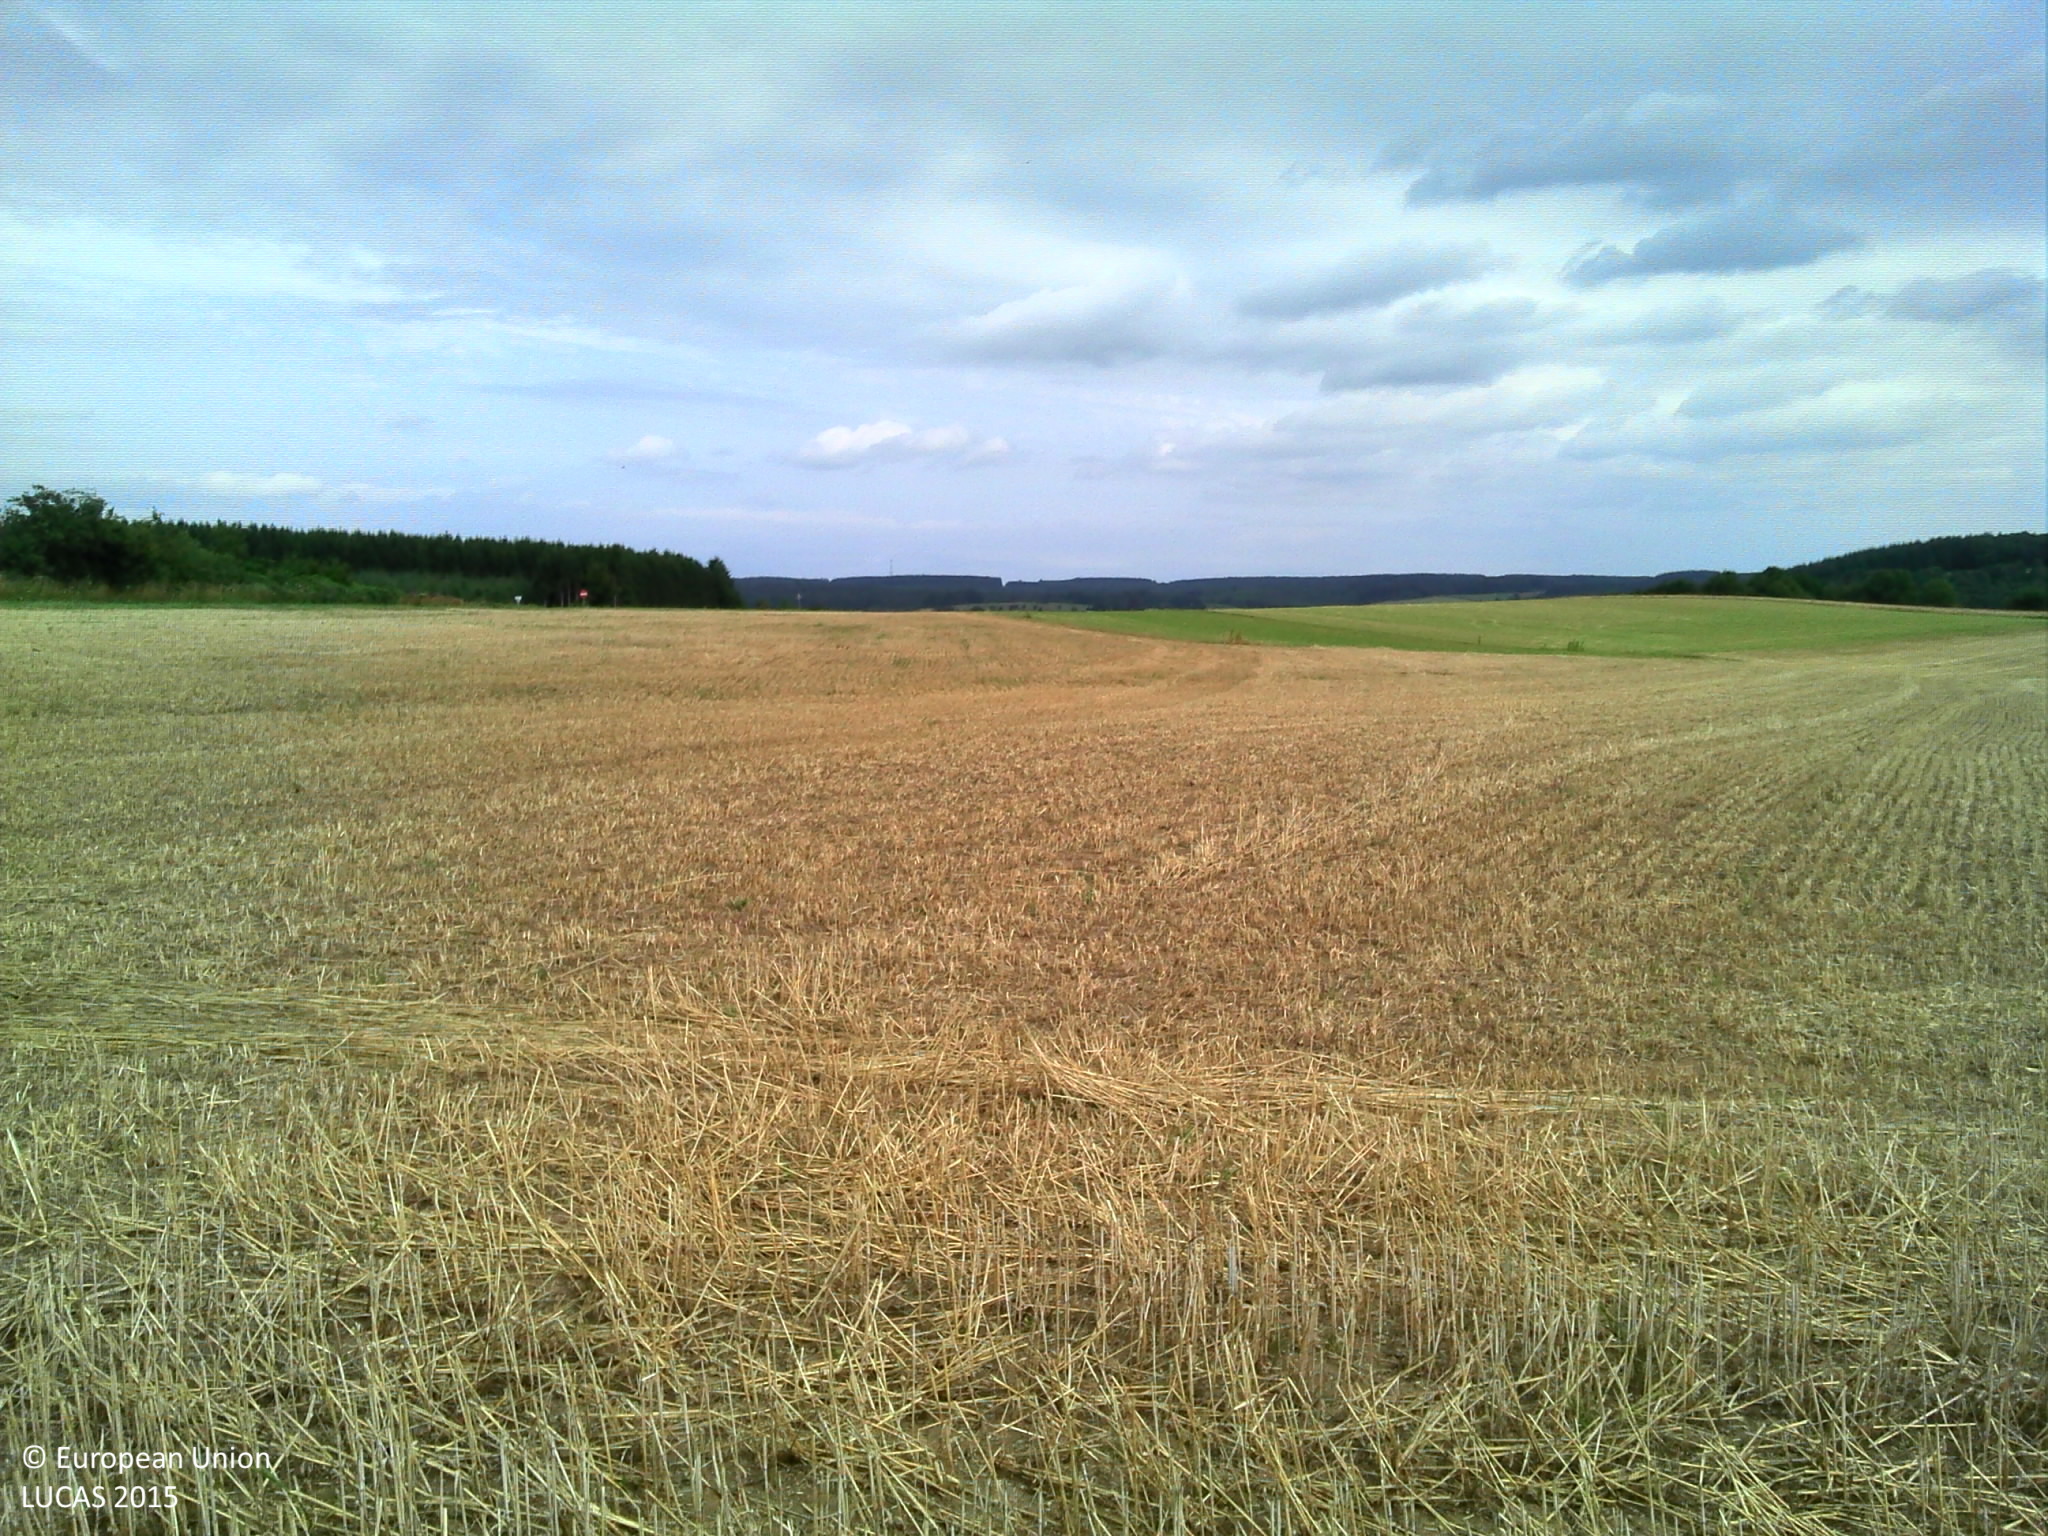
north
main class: Cropland
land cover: Maize
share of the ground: > 75 %
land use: Agriculture (excluding fallow land and kitchen gardens)
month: July
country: BE
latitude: 49.7908
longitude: 5.5395
